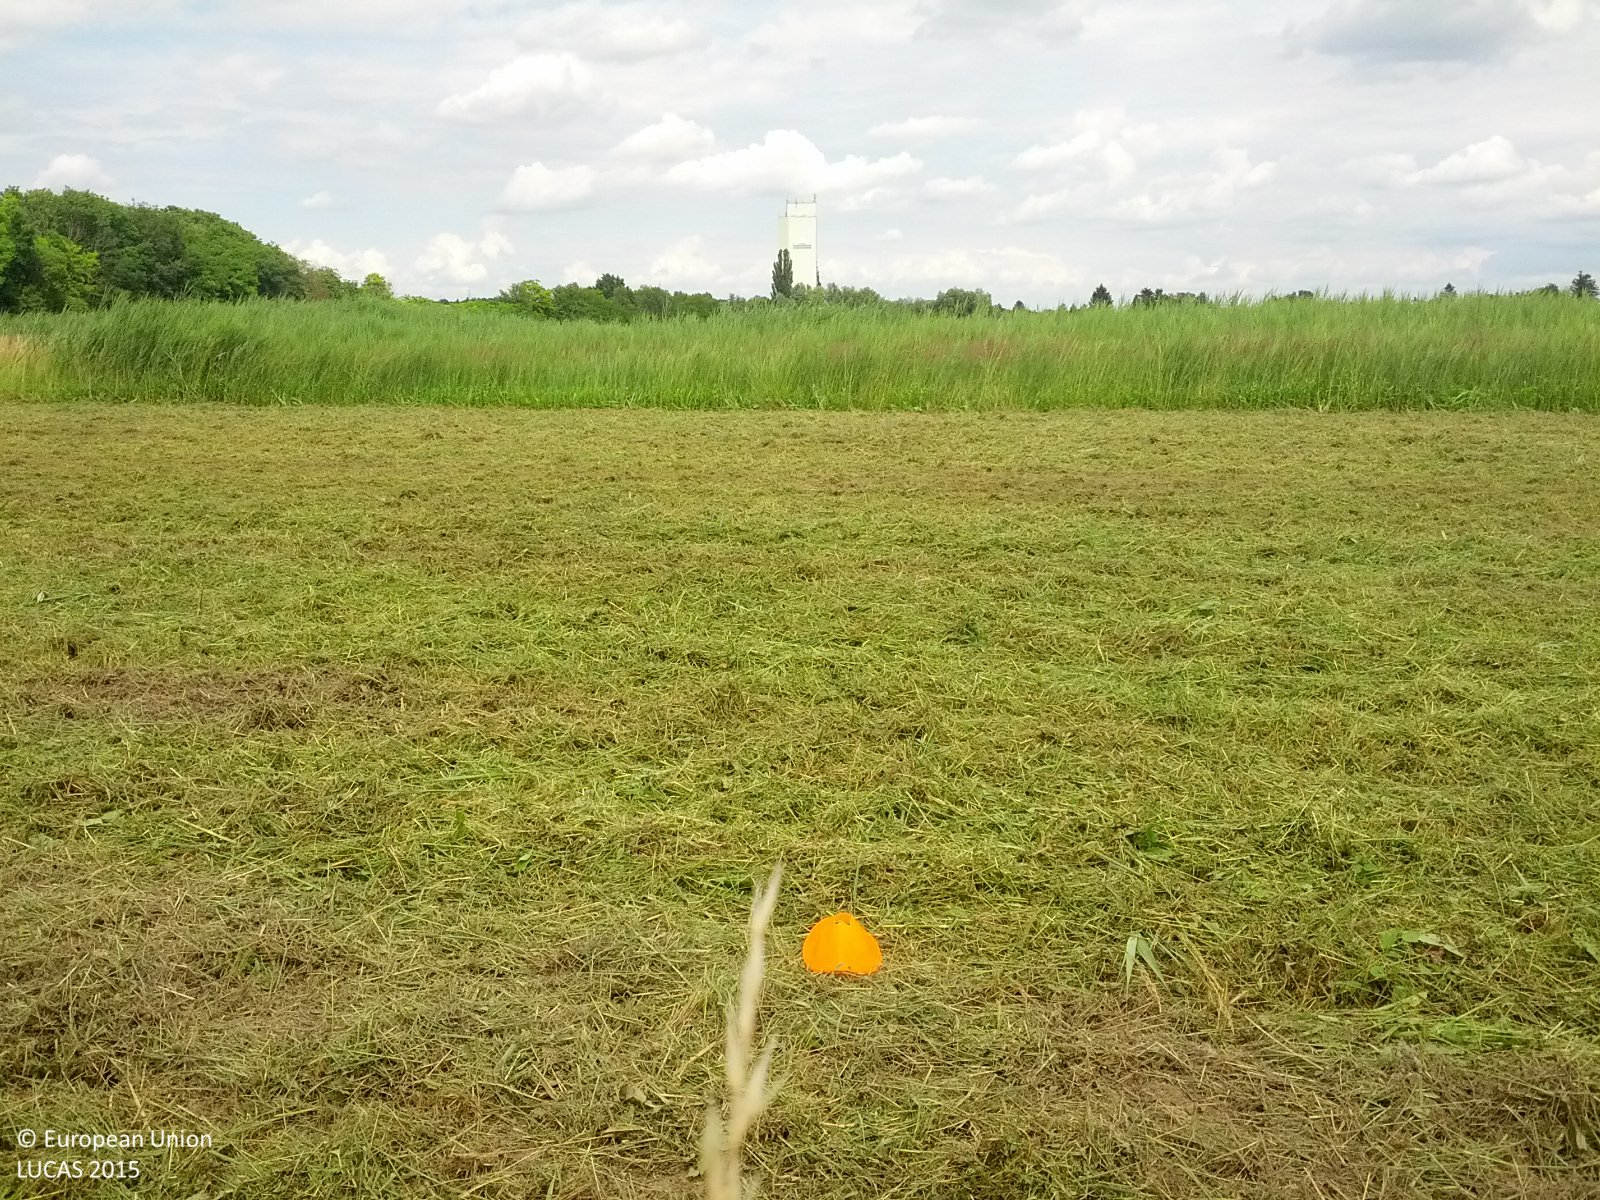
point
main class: Grassland
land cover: Grassland without tree/shrub cover
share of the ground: > 75 %
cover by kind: herbaceous plants 100 %
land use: Agriculture (excluding fallow land and kitchen gardens)
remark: Harvested field
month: June
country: AT
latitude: 48.4643
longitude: 16.8099
